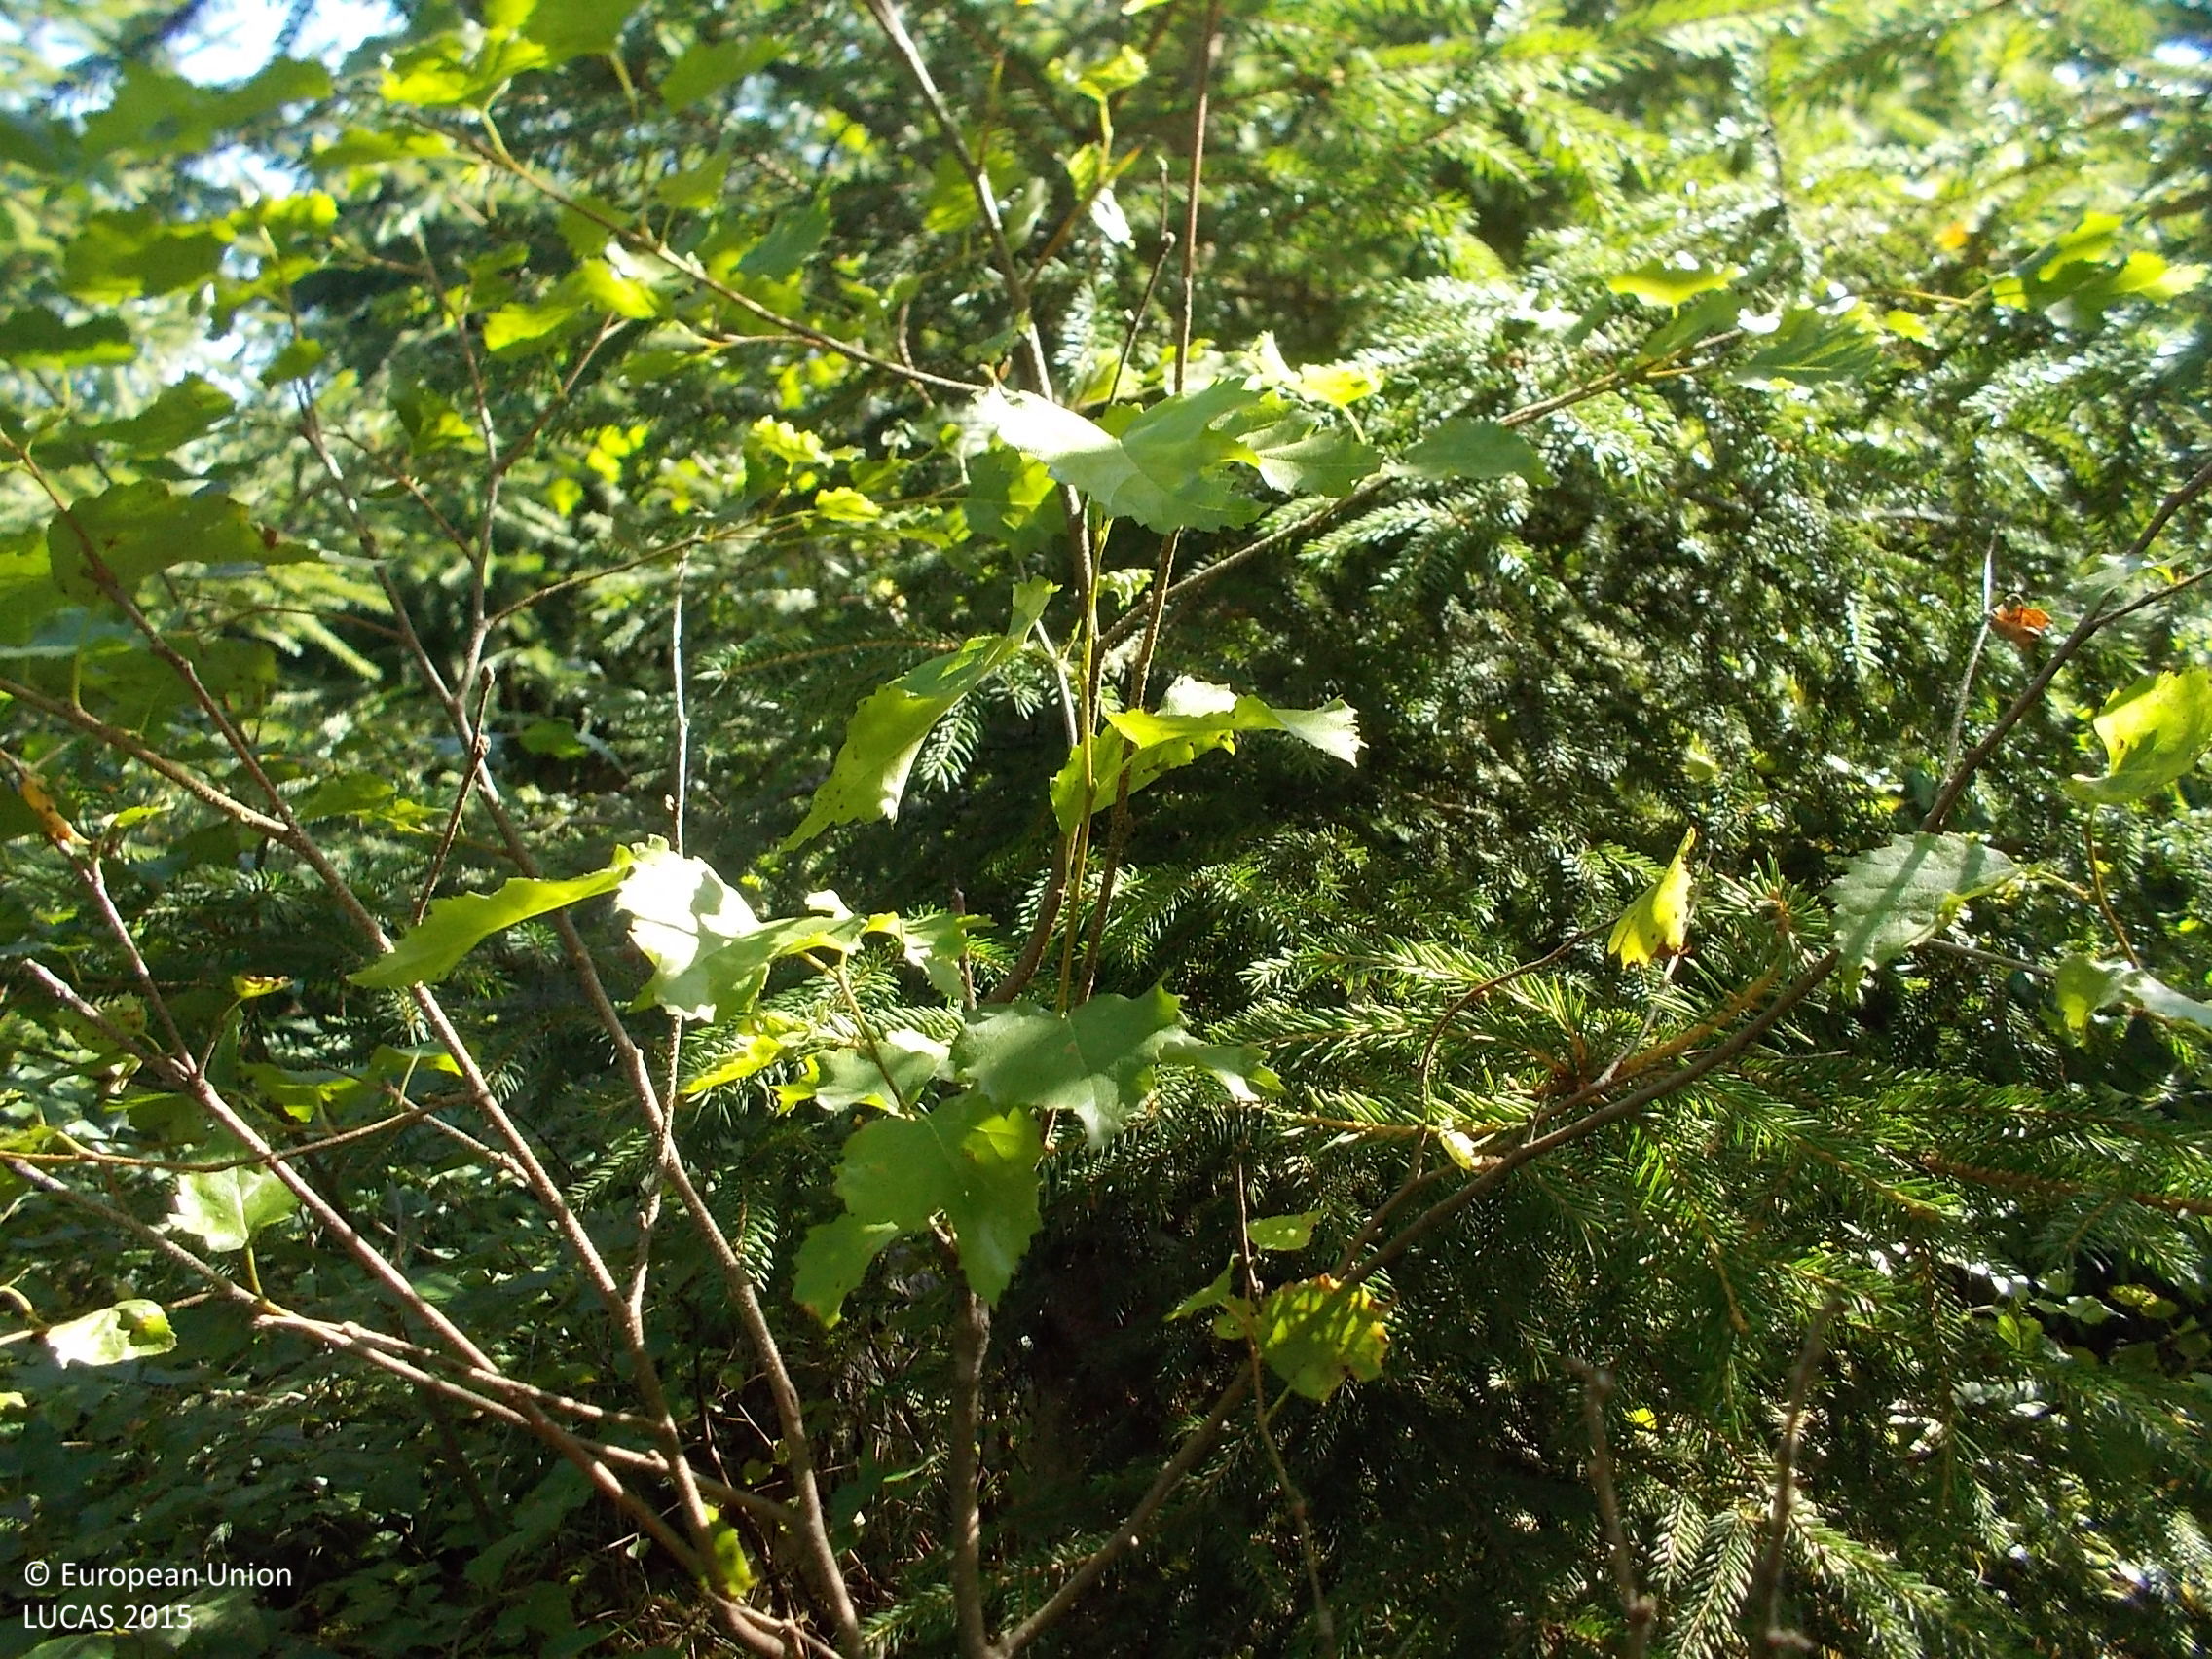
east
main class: Woodland
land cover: Spruce dominated mixed woodland
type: boreal forest
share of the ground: > 75 %
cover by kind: coniferous forest trees 45 %, broadleaved forest trees 40 %, herbaceous plants 10 %, lichens and mosses 5 %
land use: Forestry
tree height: < 5 m
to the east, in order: Spruce dominated mixed woodland; Paved roads, cycling and walking lanes; Spruce dominated mixed woodland
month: August
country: SE
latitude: 57.4612
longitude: 13.2129
